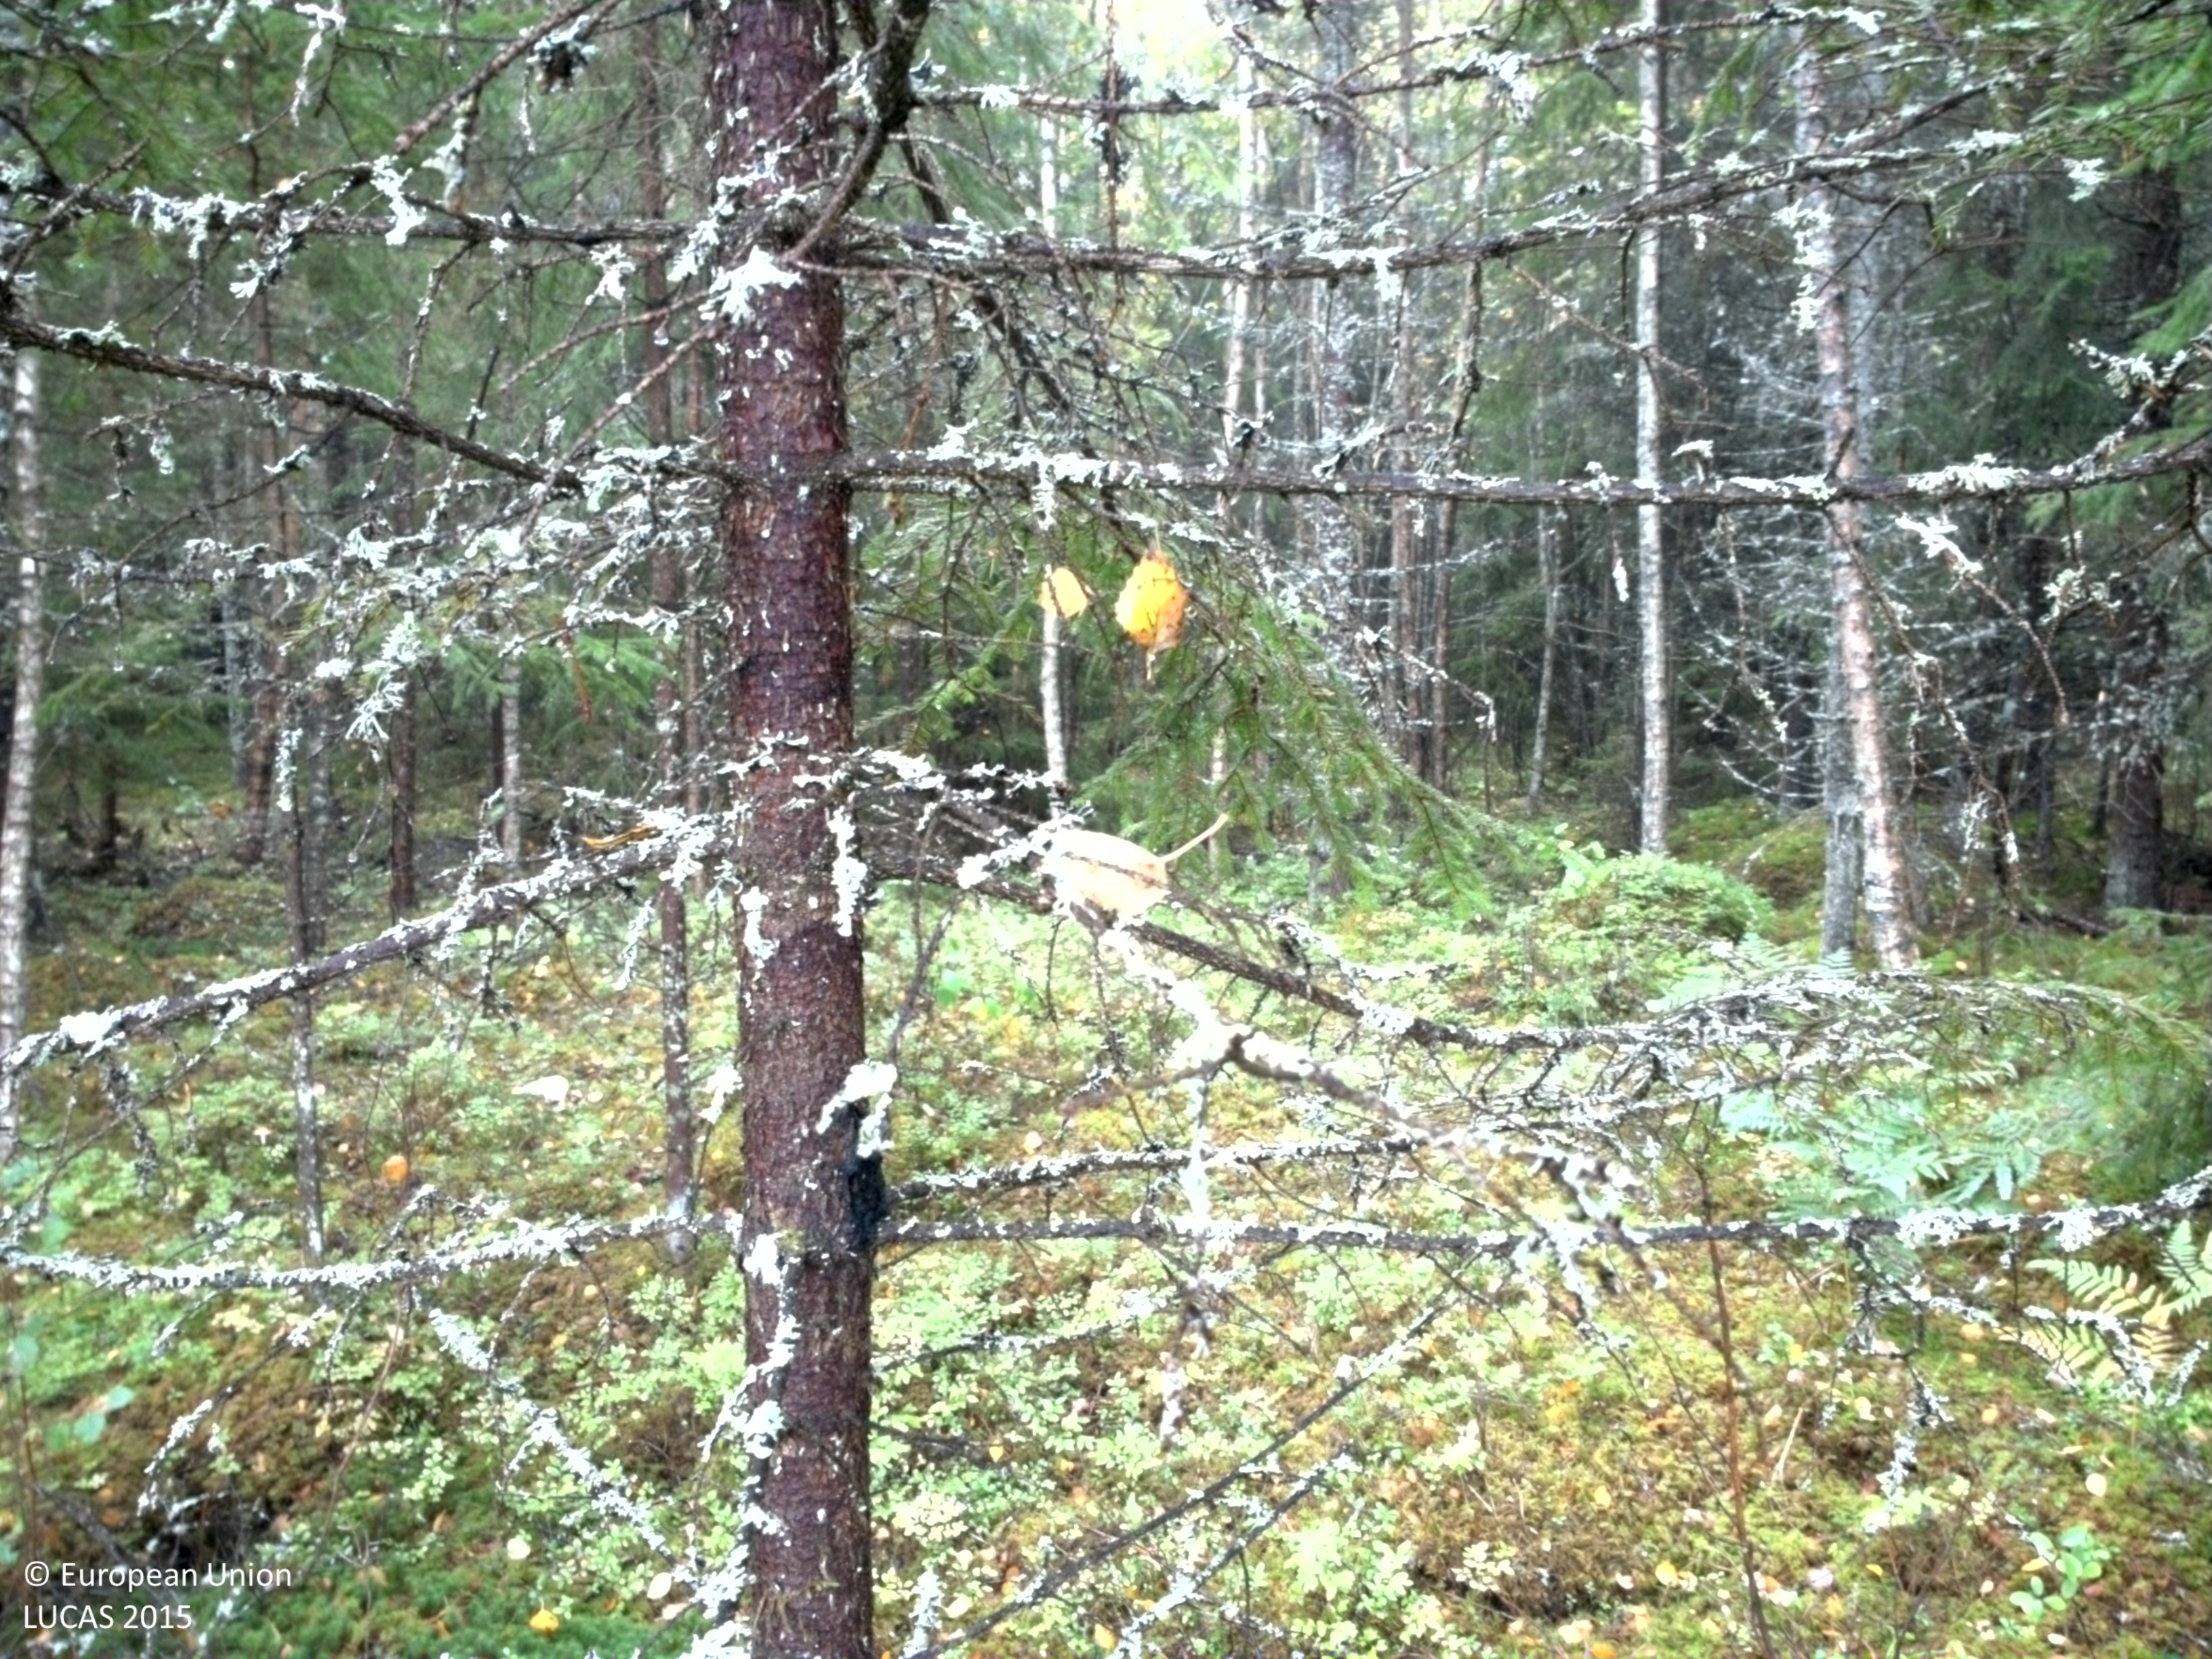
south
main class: Woodland
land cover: Spruce dominated mixed woodland
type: boreal forest
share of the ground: 50 - 75 %
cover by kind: coniferous forest trees 30 %, broadleaved forest trees 20 %, shrubs 20 %, lichens and mosses 20 %, herbaceous plants 10 %
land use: Forestry
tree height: > 5 m
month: September
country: SE
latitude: 58.9693
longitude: 14.0448
